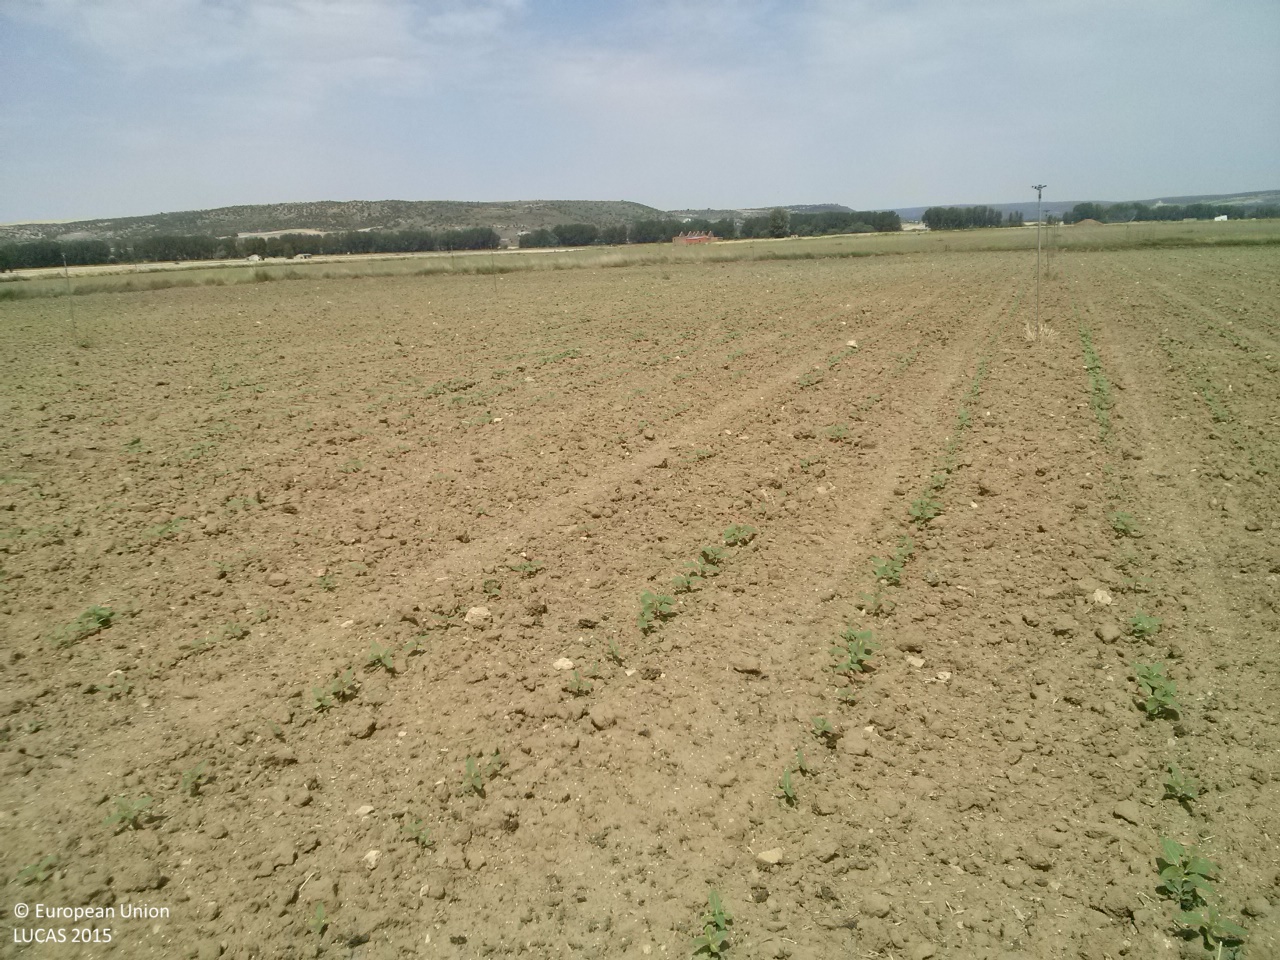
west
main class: Cropland
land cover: Sunflower
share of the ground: < 10 %
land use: Agriculture (excluding fallow land and kitchen gardens)
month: June
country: ES
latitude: 39.9311
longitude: -1.8419
